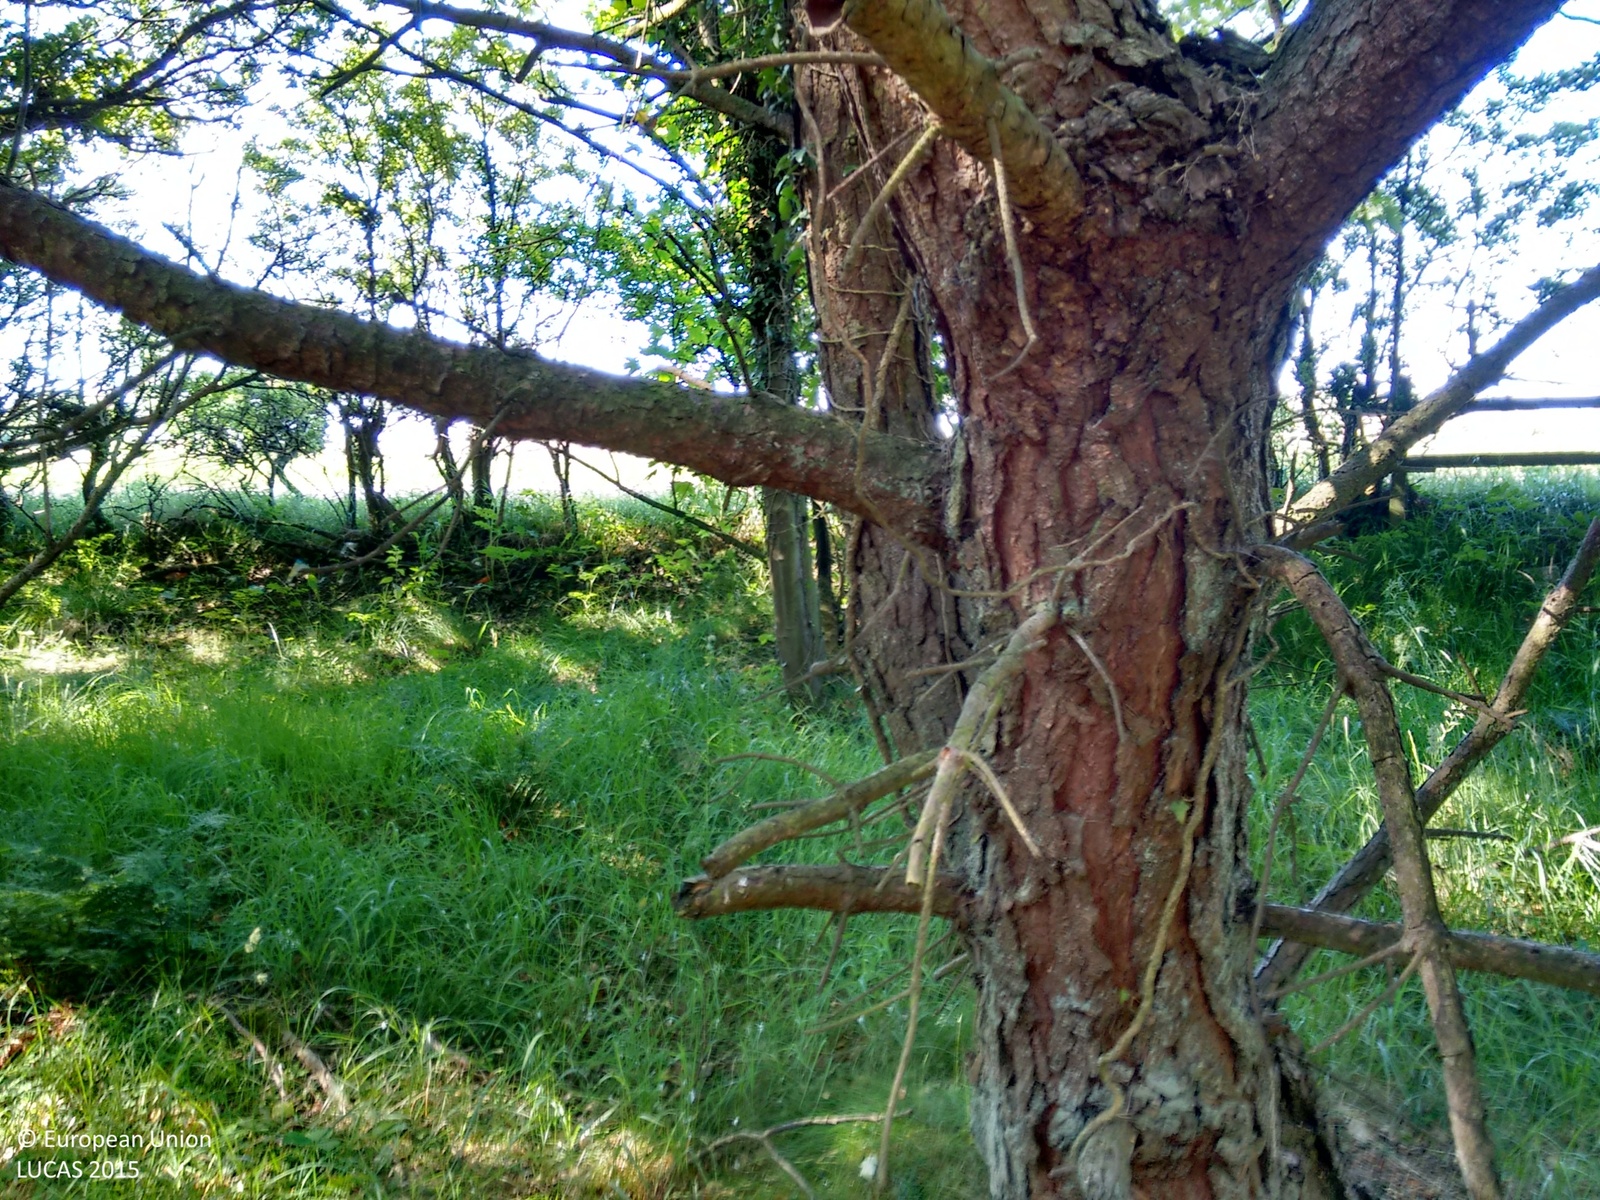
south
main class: Woodland
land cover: Other mixed woodland
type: hemiboreal forest and nemoral coniferous forest and mixed broadleaved-coniferous forest
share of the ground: > 75 %
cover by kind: broadleaved forest trees 60 %, coniferous forest trees 40 %
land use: Forestry
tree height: > 5 m
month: July
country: GB
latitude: 54.3601
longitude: -0.4848
